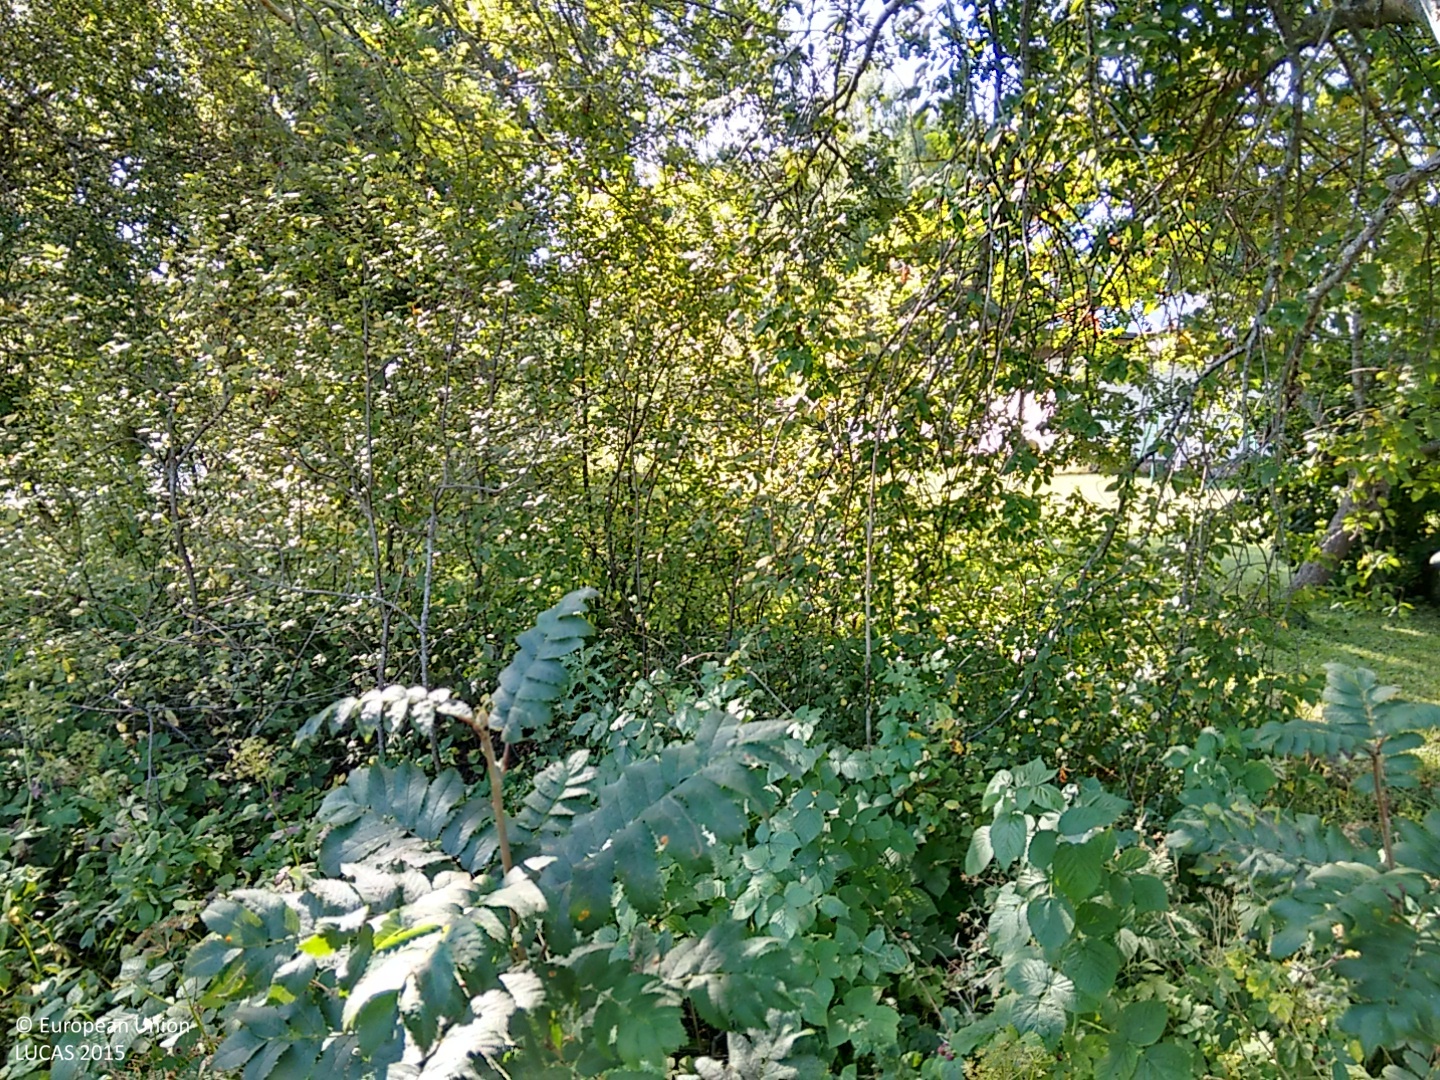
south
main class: Woodland
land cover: Broadleaved woodland
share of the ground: 50 - 75 %
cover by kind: broadleaved forest trees 70 %, herbaceous plants 30 %
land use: Residential
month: August
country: FI
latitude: 60.2402
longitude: 20.0309
